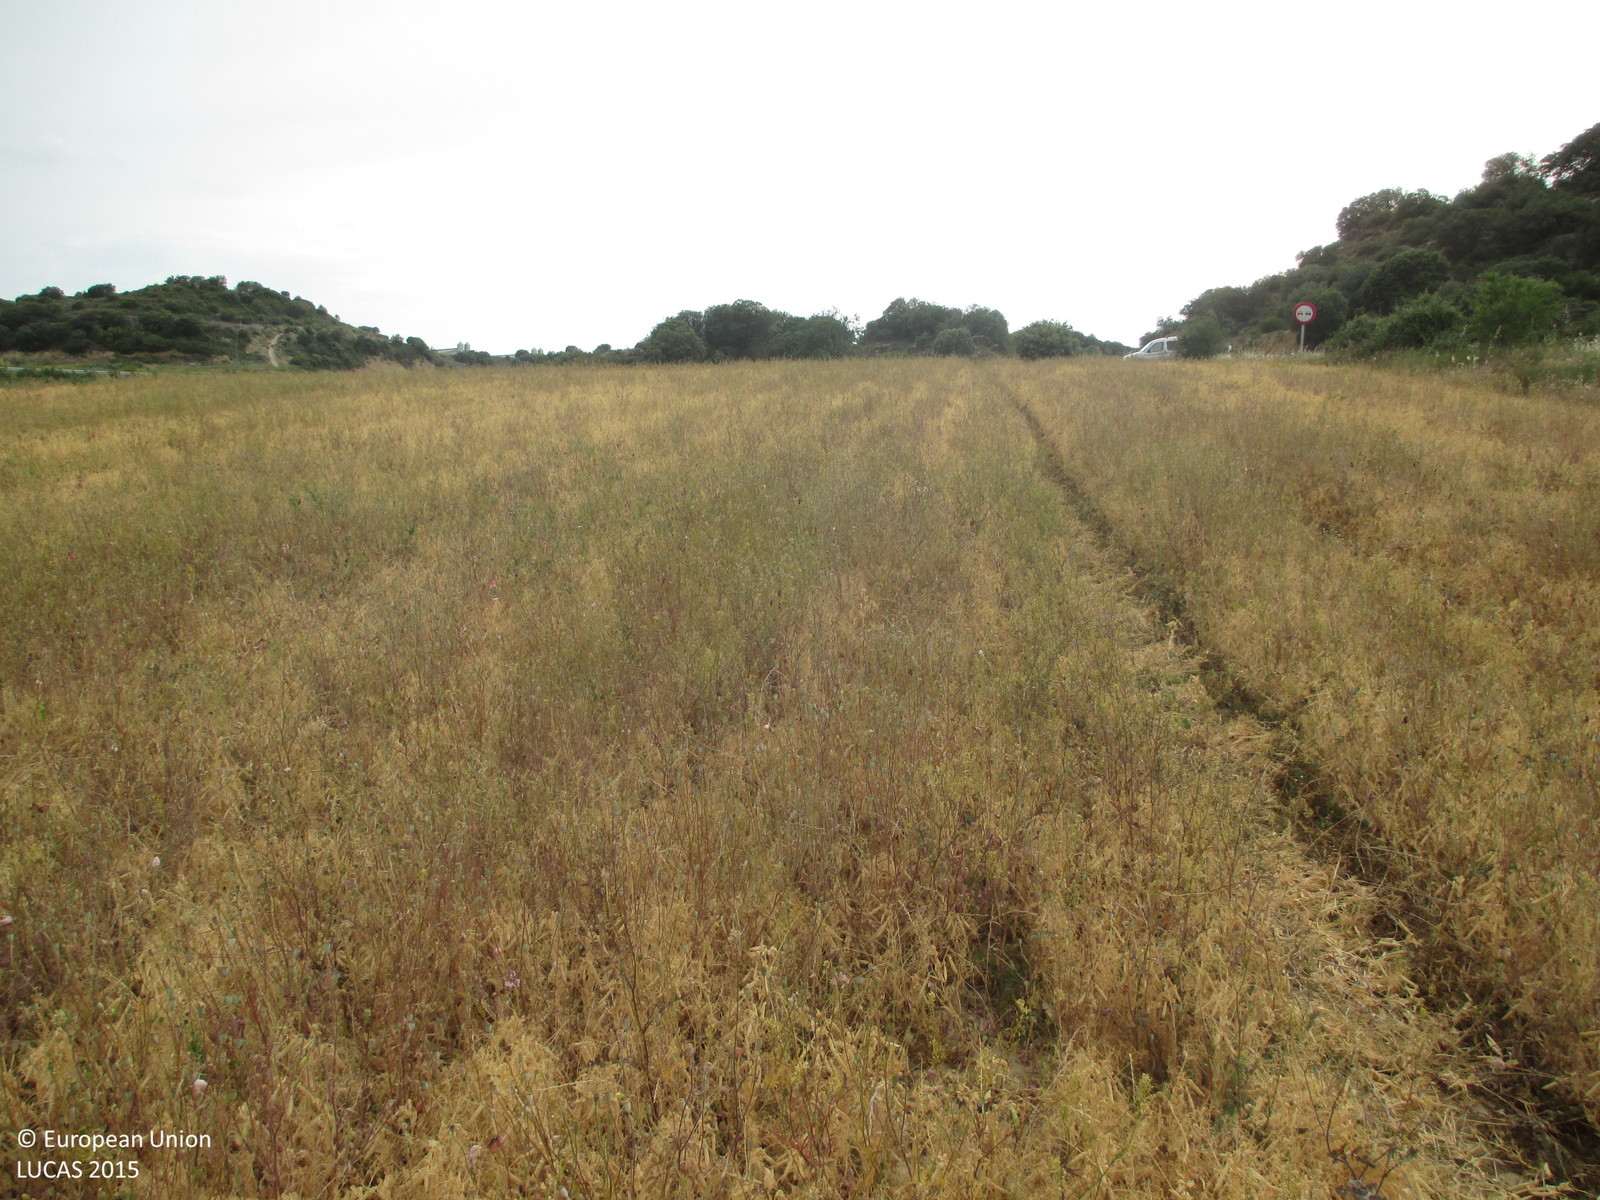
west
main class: Cropland
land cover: Dry pulses
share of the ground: > 75 %
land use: Agriculture (excluding fallow land and kitchen gardens)
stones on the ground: < 10 %
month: May
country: ES
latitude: 42.1154
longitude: -0.2412
